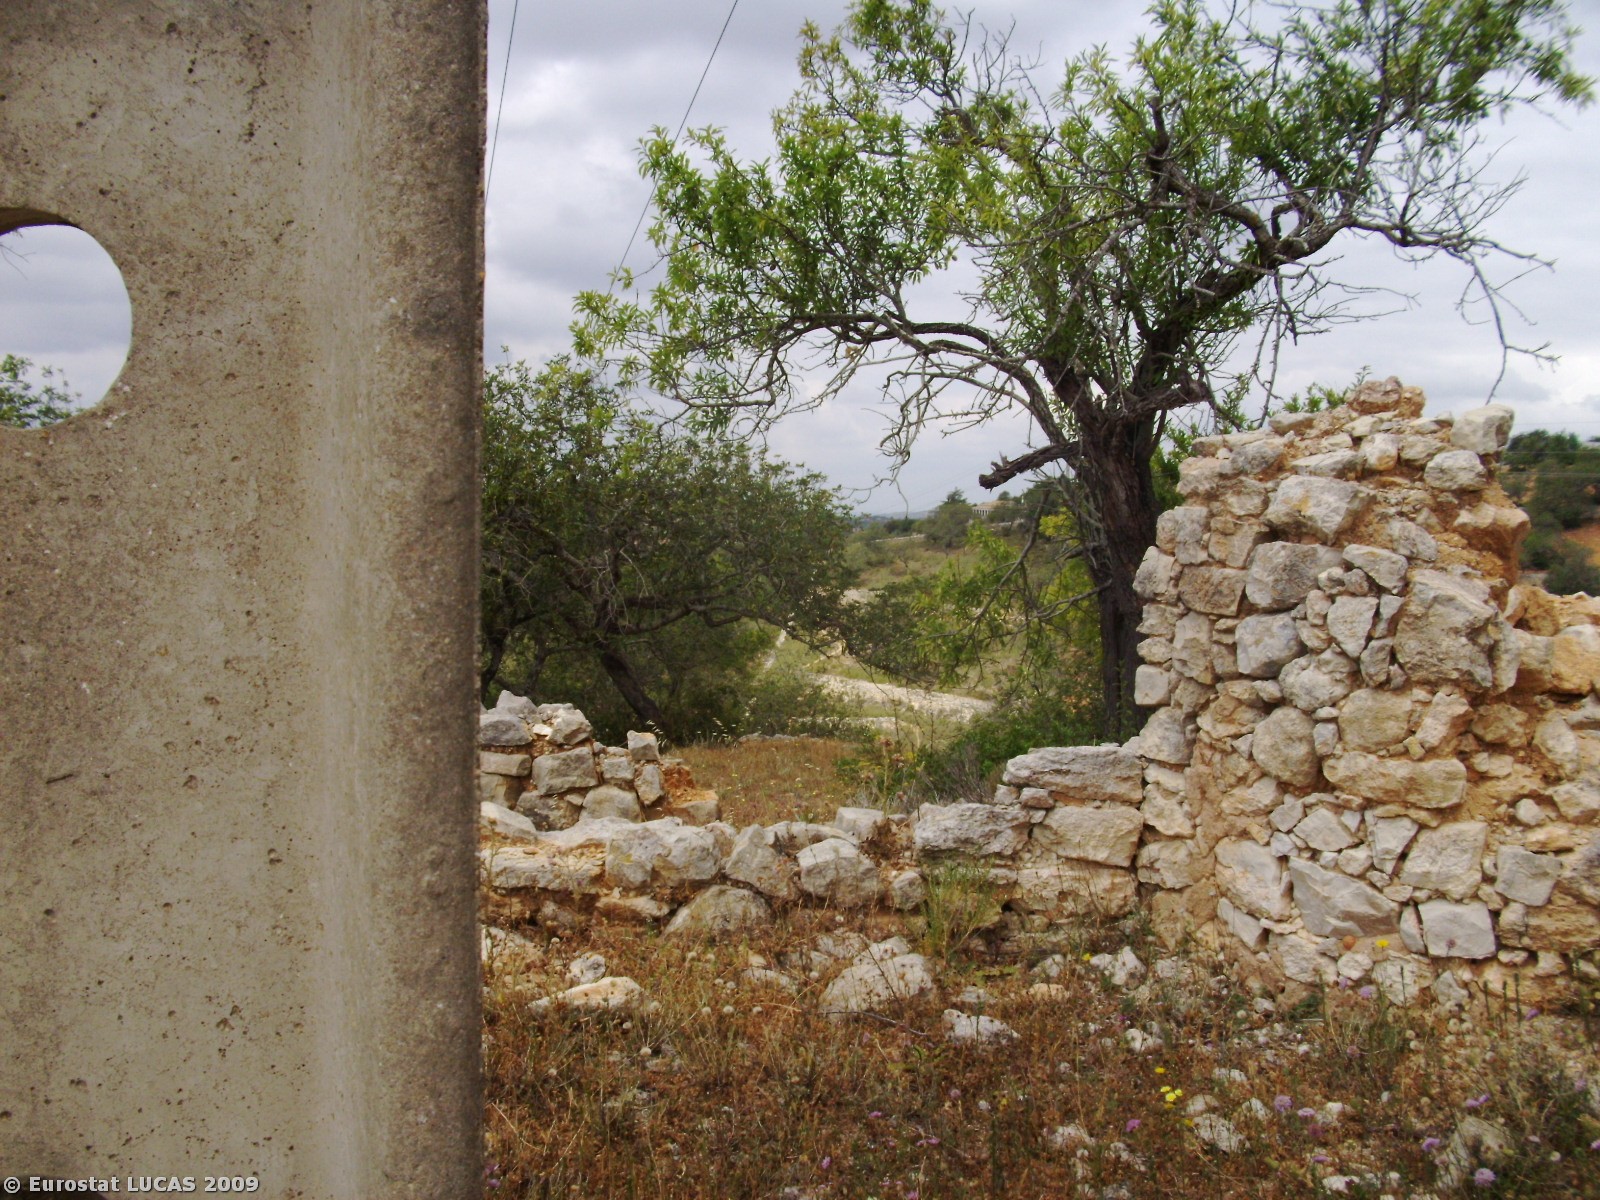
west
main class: Grassland
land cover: Spontaneously vegetated surfaces
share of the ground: 25 - 50 %
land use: Unused
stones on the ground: 25 - 50 %
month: May
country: PT
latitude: 37.1510
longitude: -8.1553
